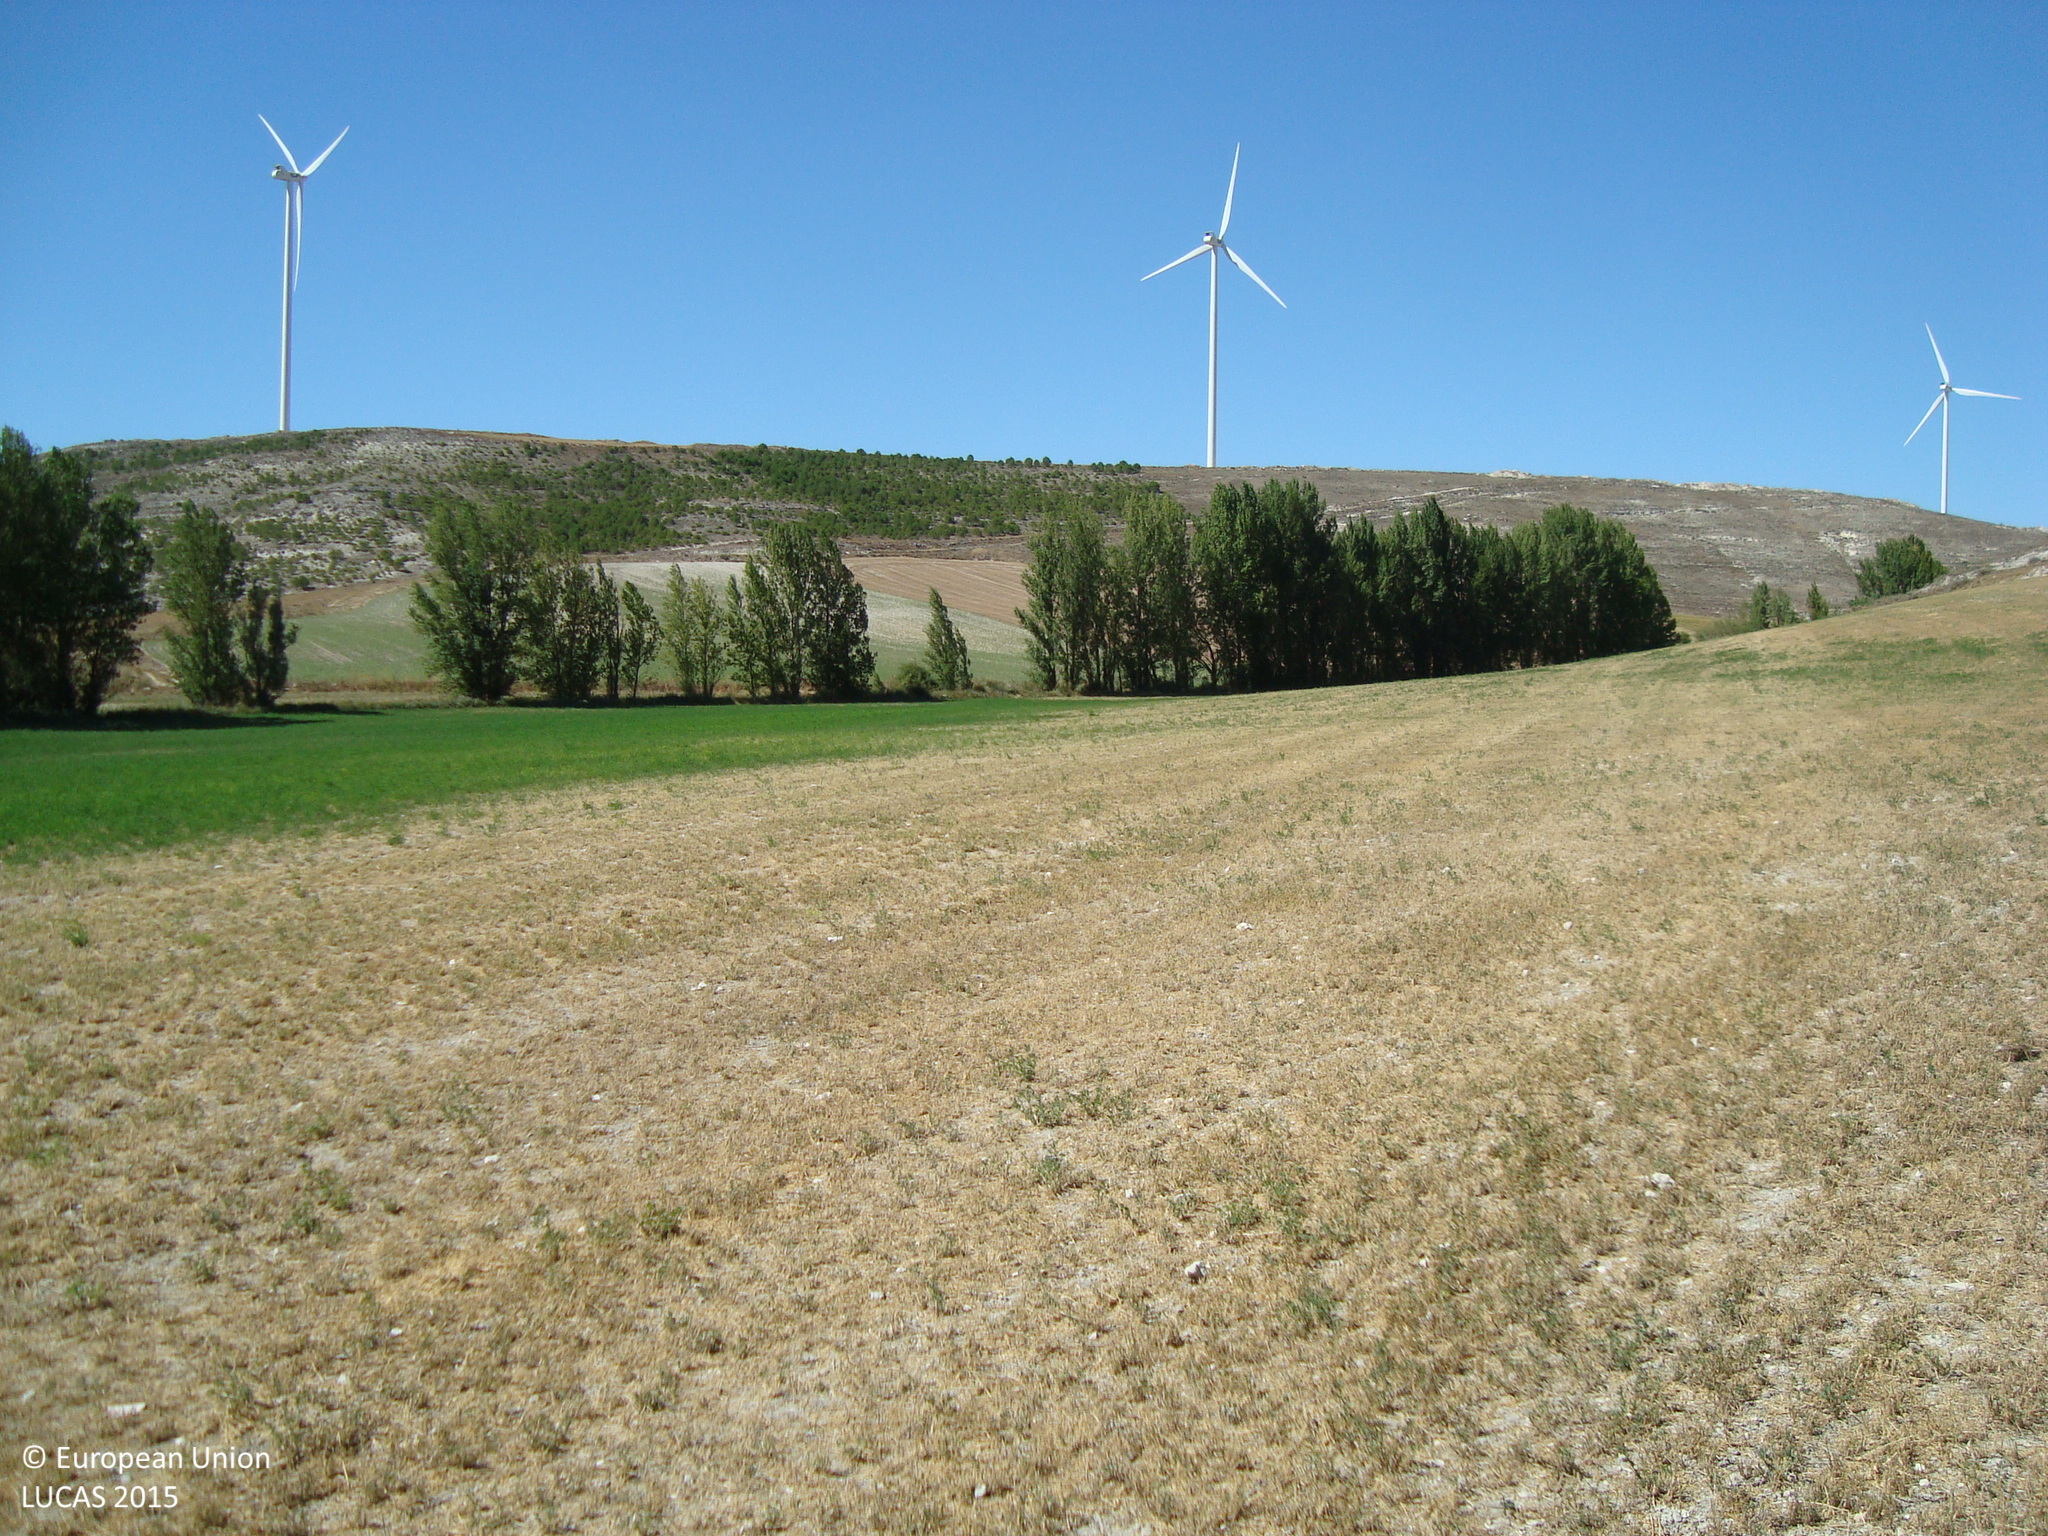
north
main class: Cropland
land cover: Lucerne
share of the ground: > 75 %
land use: Agriculture (excluding fallow land and kitchen gardens)
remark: Harvested field
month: August
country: ES
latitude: 42.1862
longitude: -4.1476
